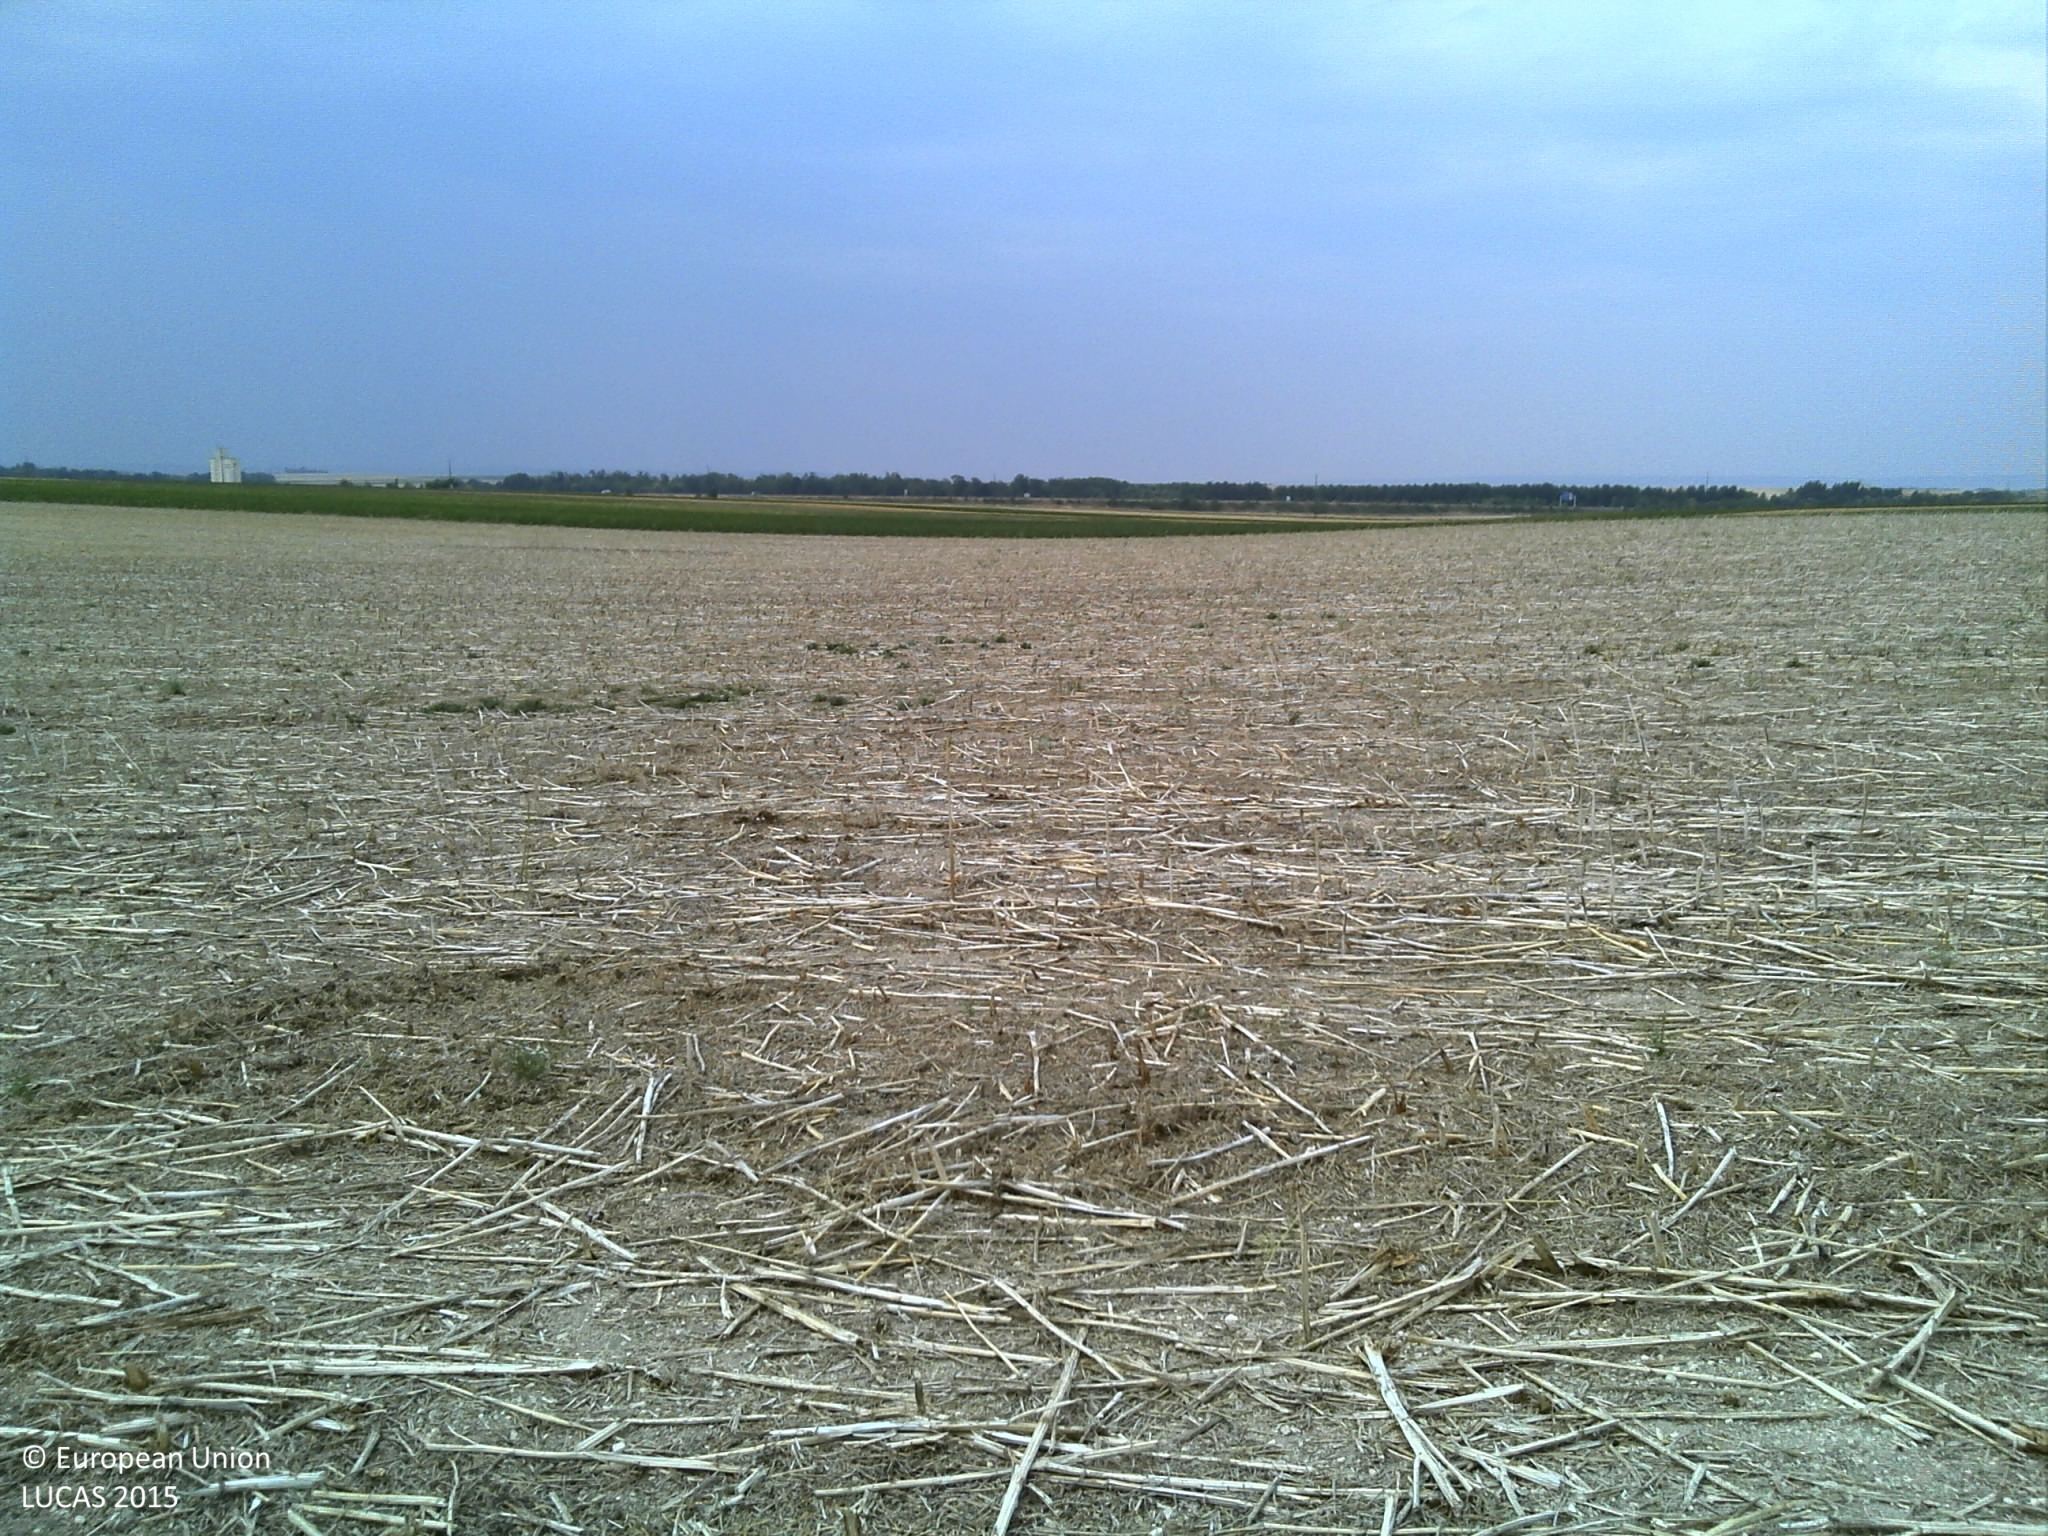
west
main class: Cropland
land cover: Rape and turnip rape
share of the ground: > 75 %
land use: Agriculture (excluding fallow land and kitchen gardens)
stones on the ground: < 10 %
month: August
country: FR
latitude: 48.9599
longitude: 4.3008
